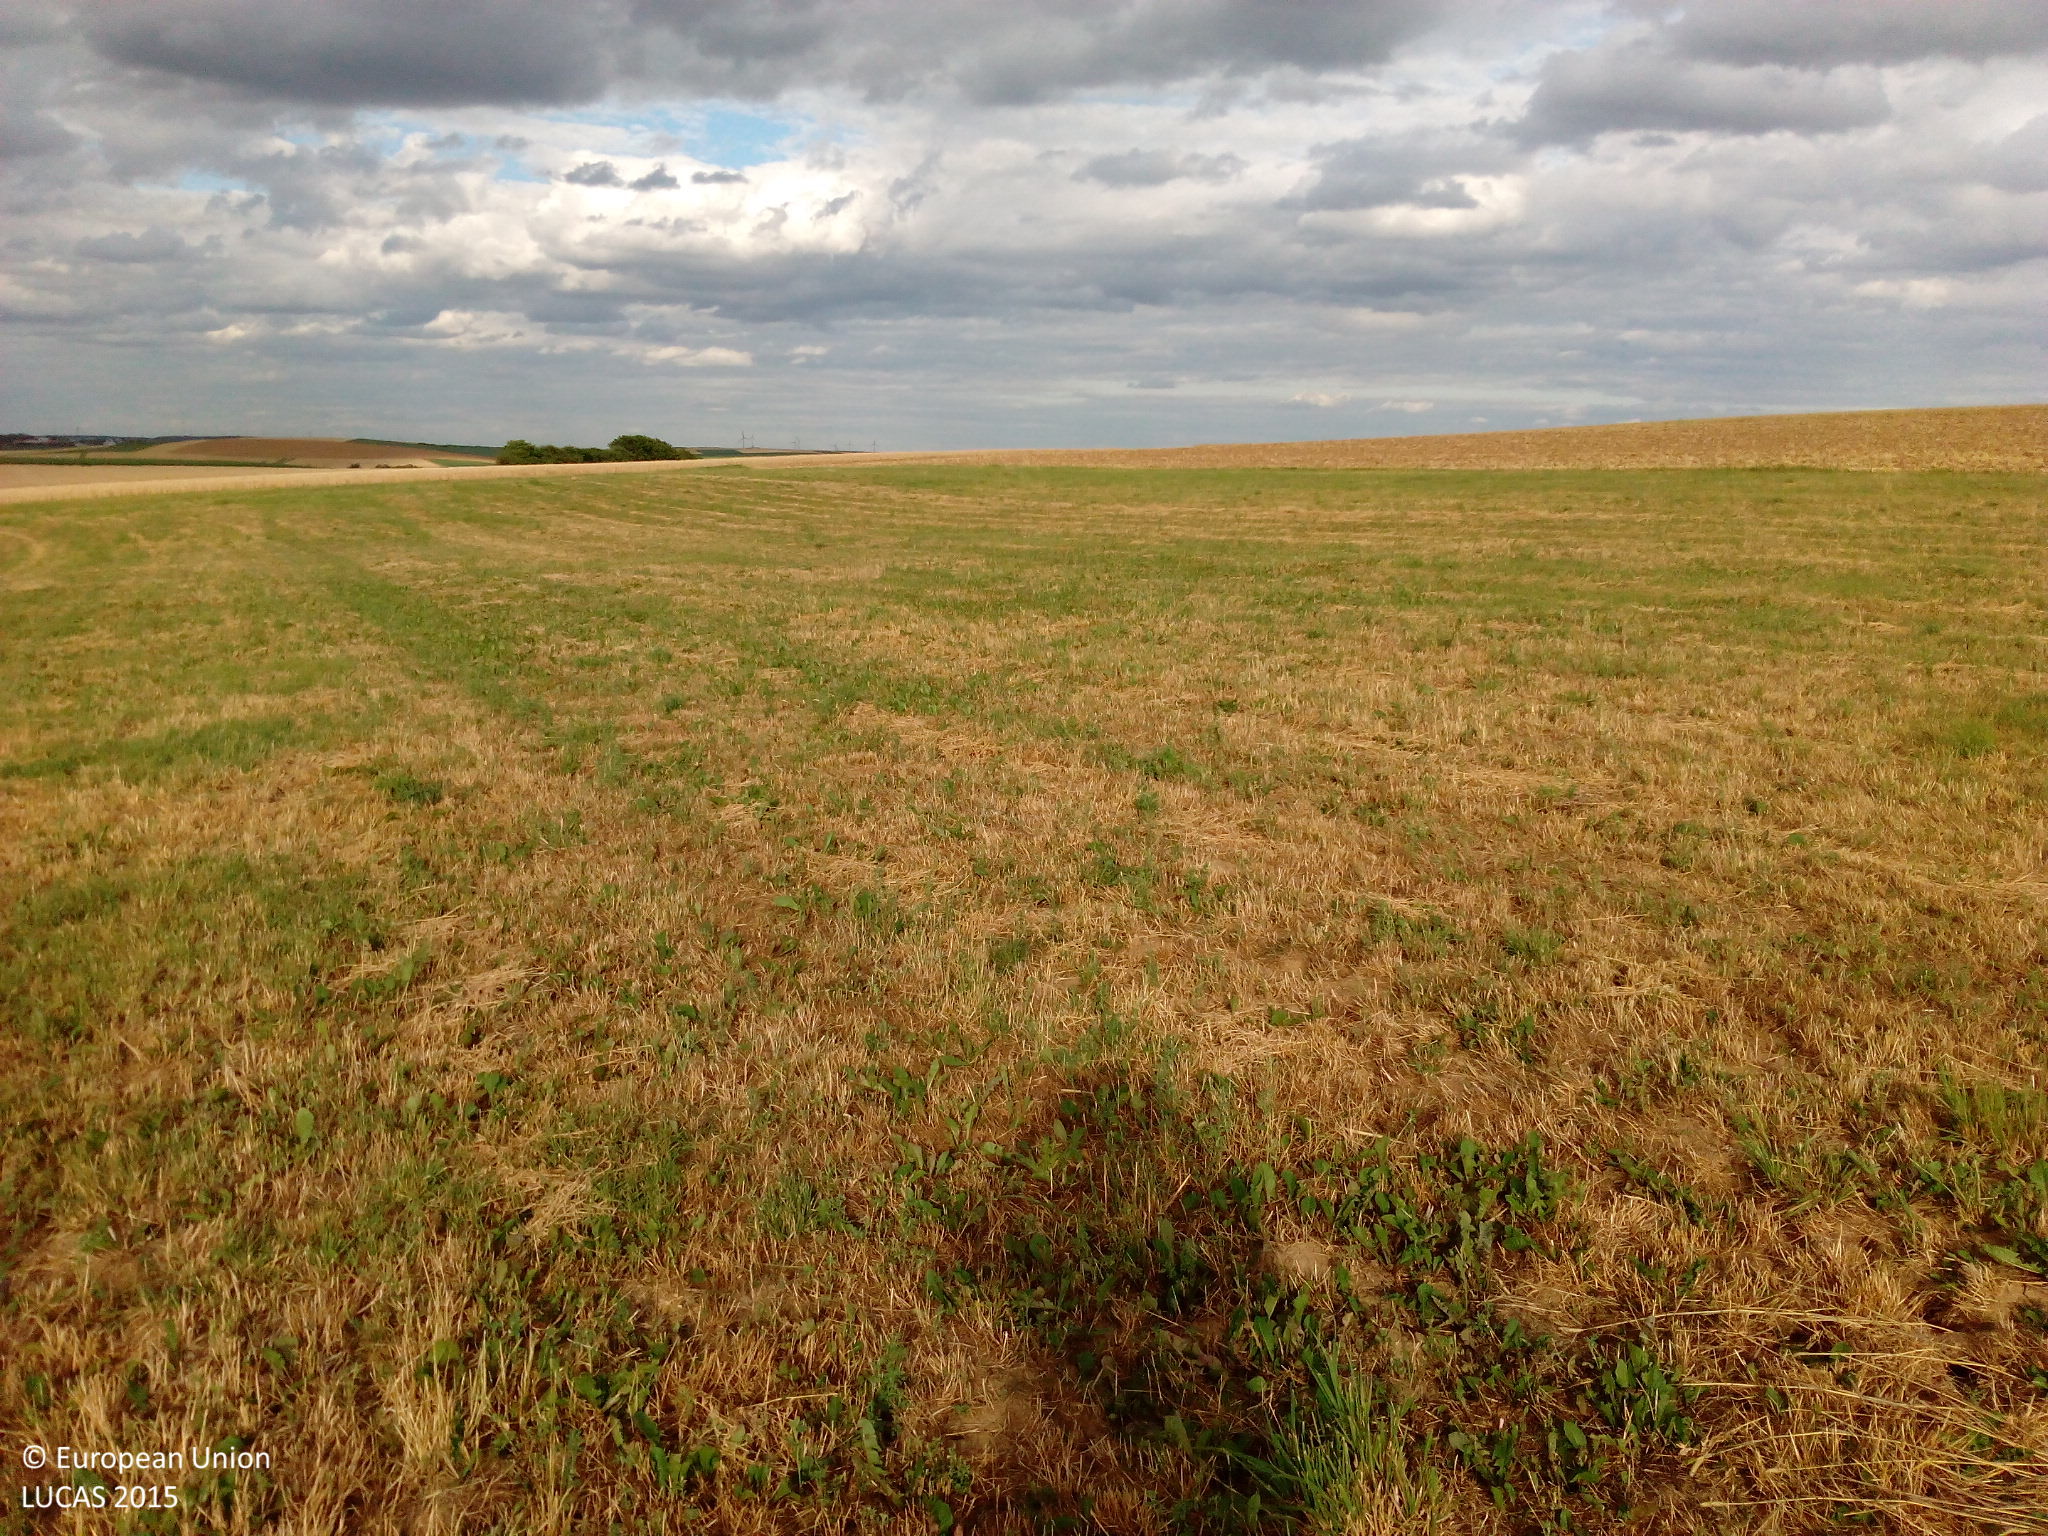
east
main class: Grassland
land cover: Grassland without tree/shrub cover
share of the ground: > 75 %
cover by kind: herbaceous plants 85 %, unconsolidated bare surface 15 %
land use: Agriculture (excluding fallow land and kitchen gardens)
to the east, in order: Grassland without tree/shrub cover; Common wheat; Tracks; Common wheat; Grass margins; Tracks; Grass margins; Common wheat
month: July
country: DE
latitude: 49.7166
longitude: 9.9030
